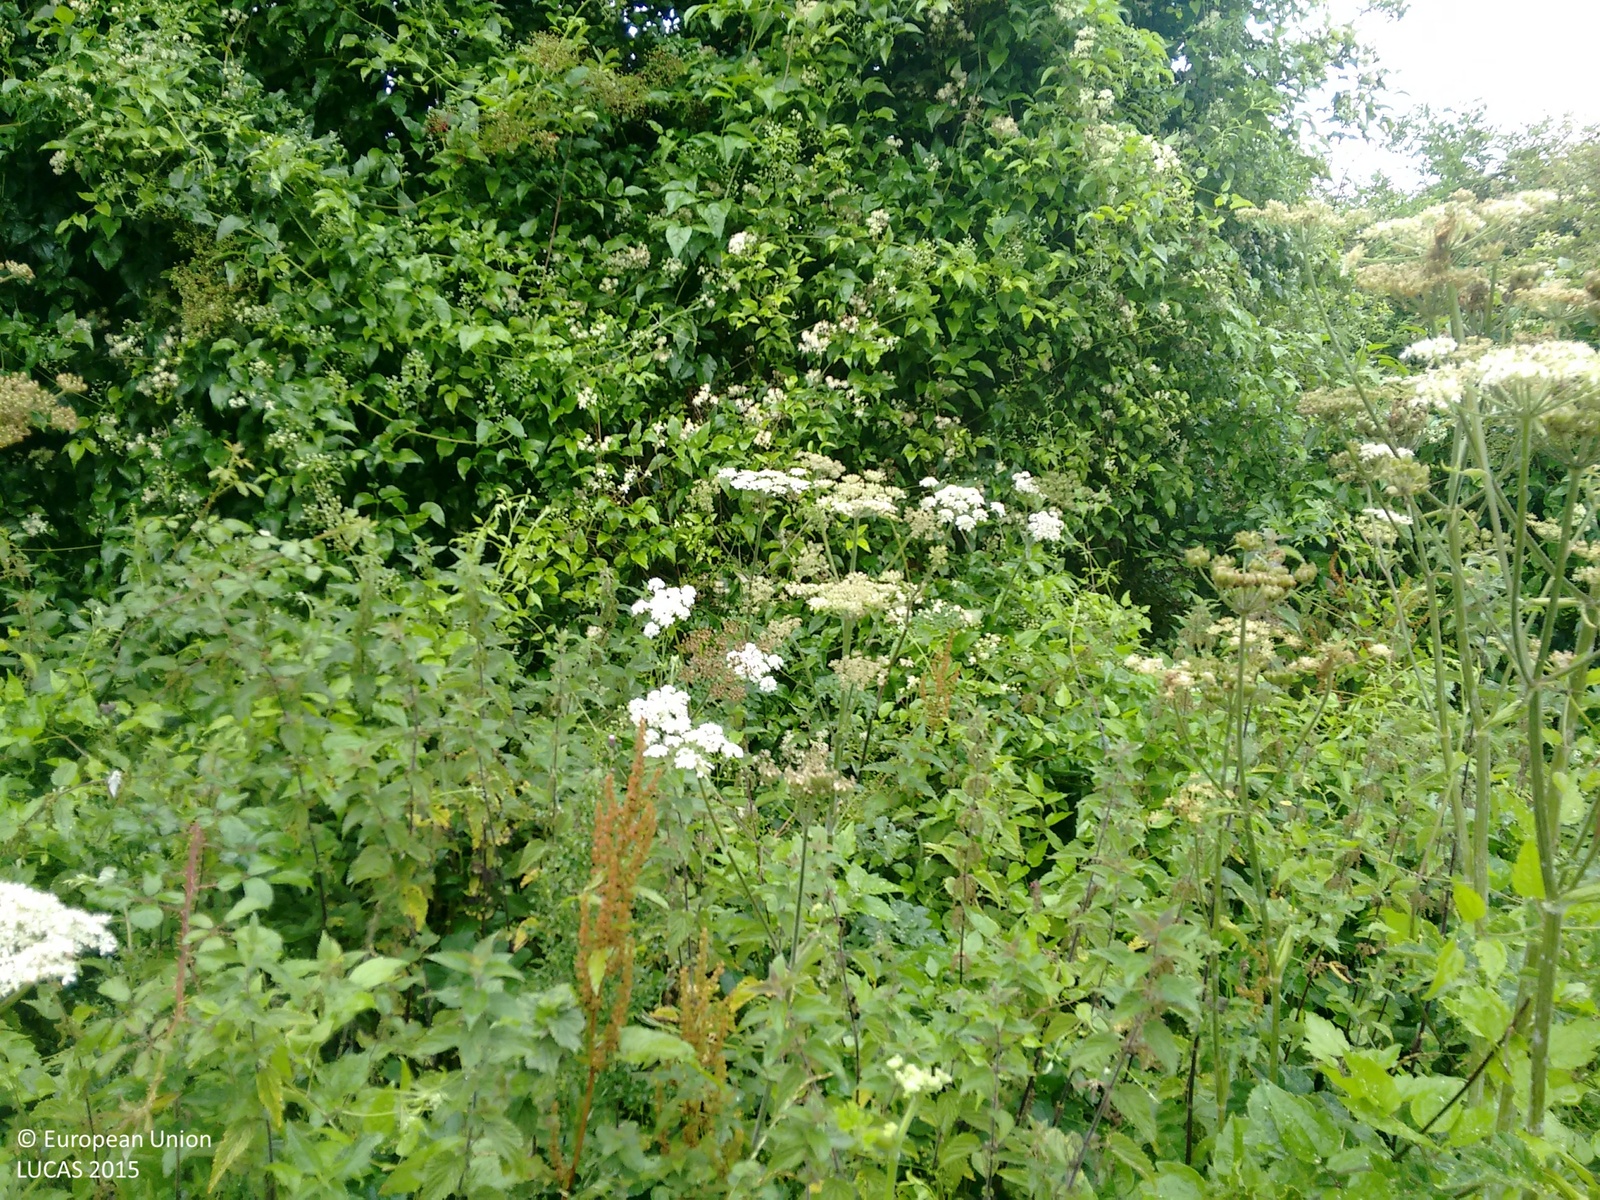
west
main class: Woodland
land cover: Broadleaved woodland
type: mesophytic deciduous forest
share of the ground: > 75 %
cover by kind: broadleaved forest trees 100 %
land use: Agriculture (excluding fallow land and kitchen gardens)
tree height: > 5 m
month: July
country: GB
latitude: 51.0411
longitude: -1.0701
